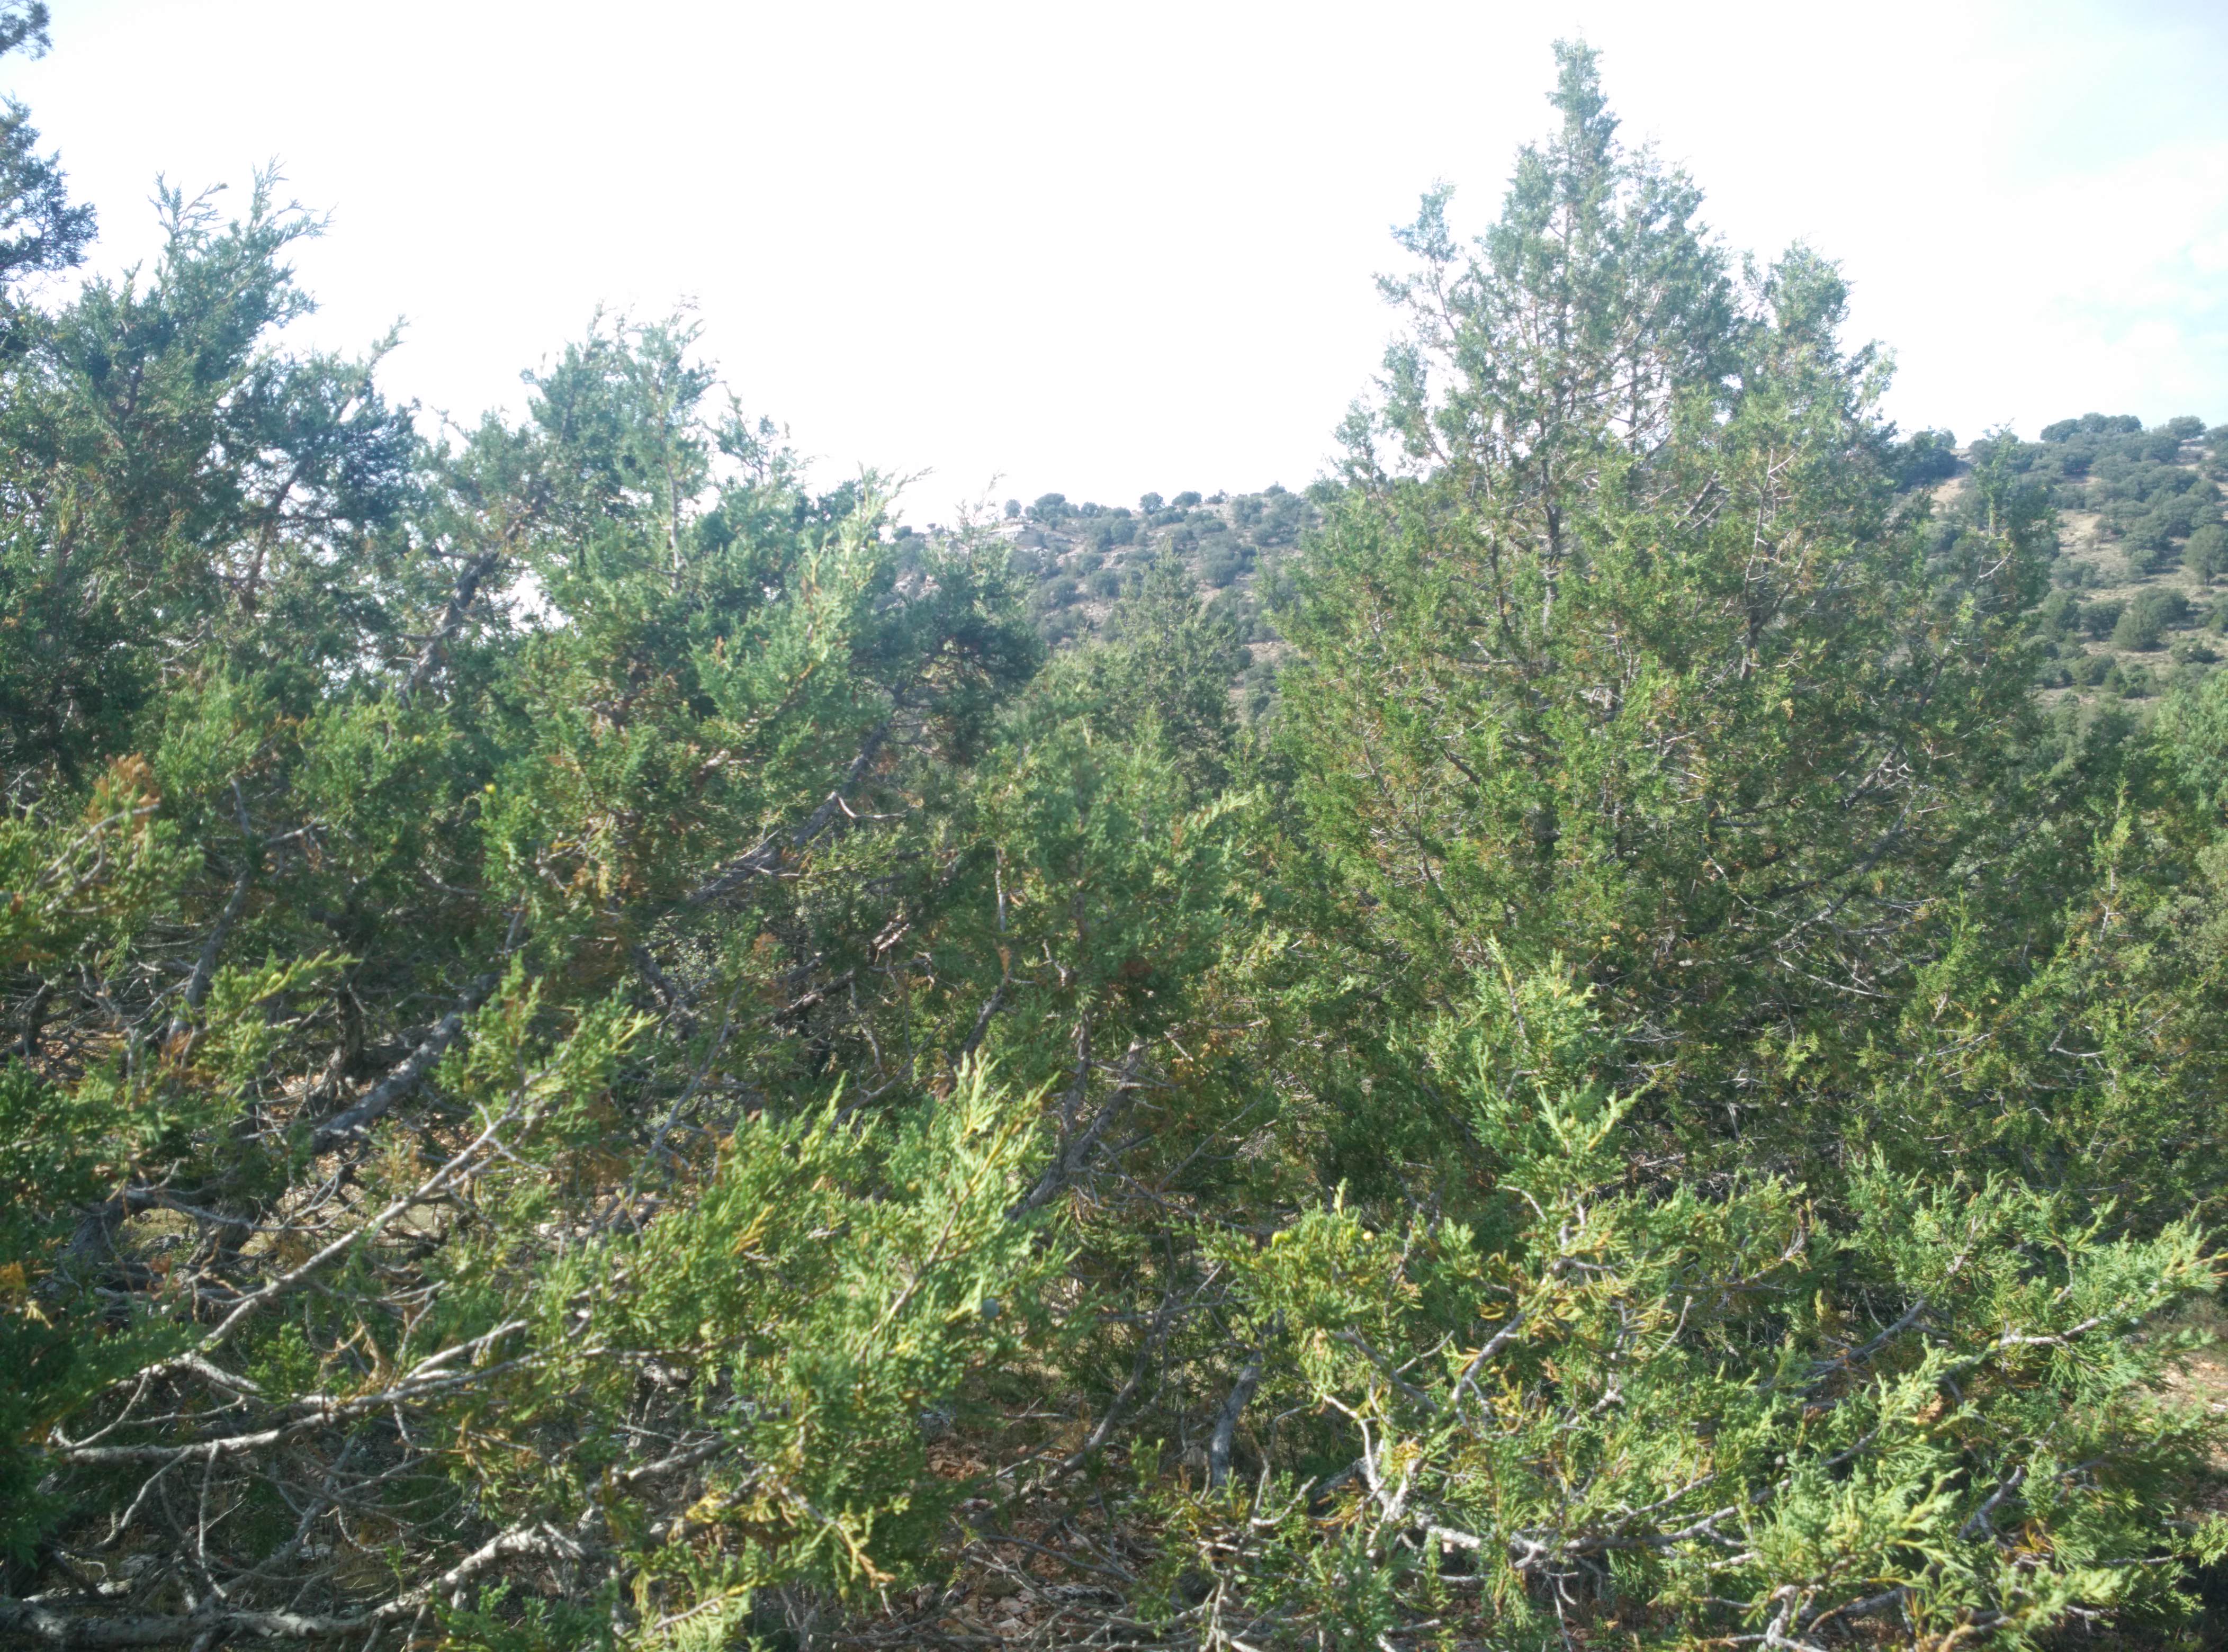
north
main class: Woodland
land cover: Other coniferous woodland
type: coniferous forest of the mediterranean region
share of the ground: 25 - 50 %
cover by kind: unconsolidated bare surface 45 %, coniferous forest trees 35 %, shrubs 10 %, broadleaved forest trees 5 %, herbaceous plants 5 %
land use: Semi-natural and natural areas not in use
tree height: > 5 m
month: July
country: ES
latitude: 41.0553
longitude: -2.0554
